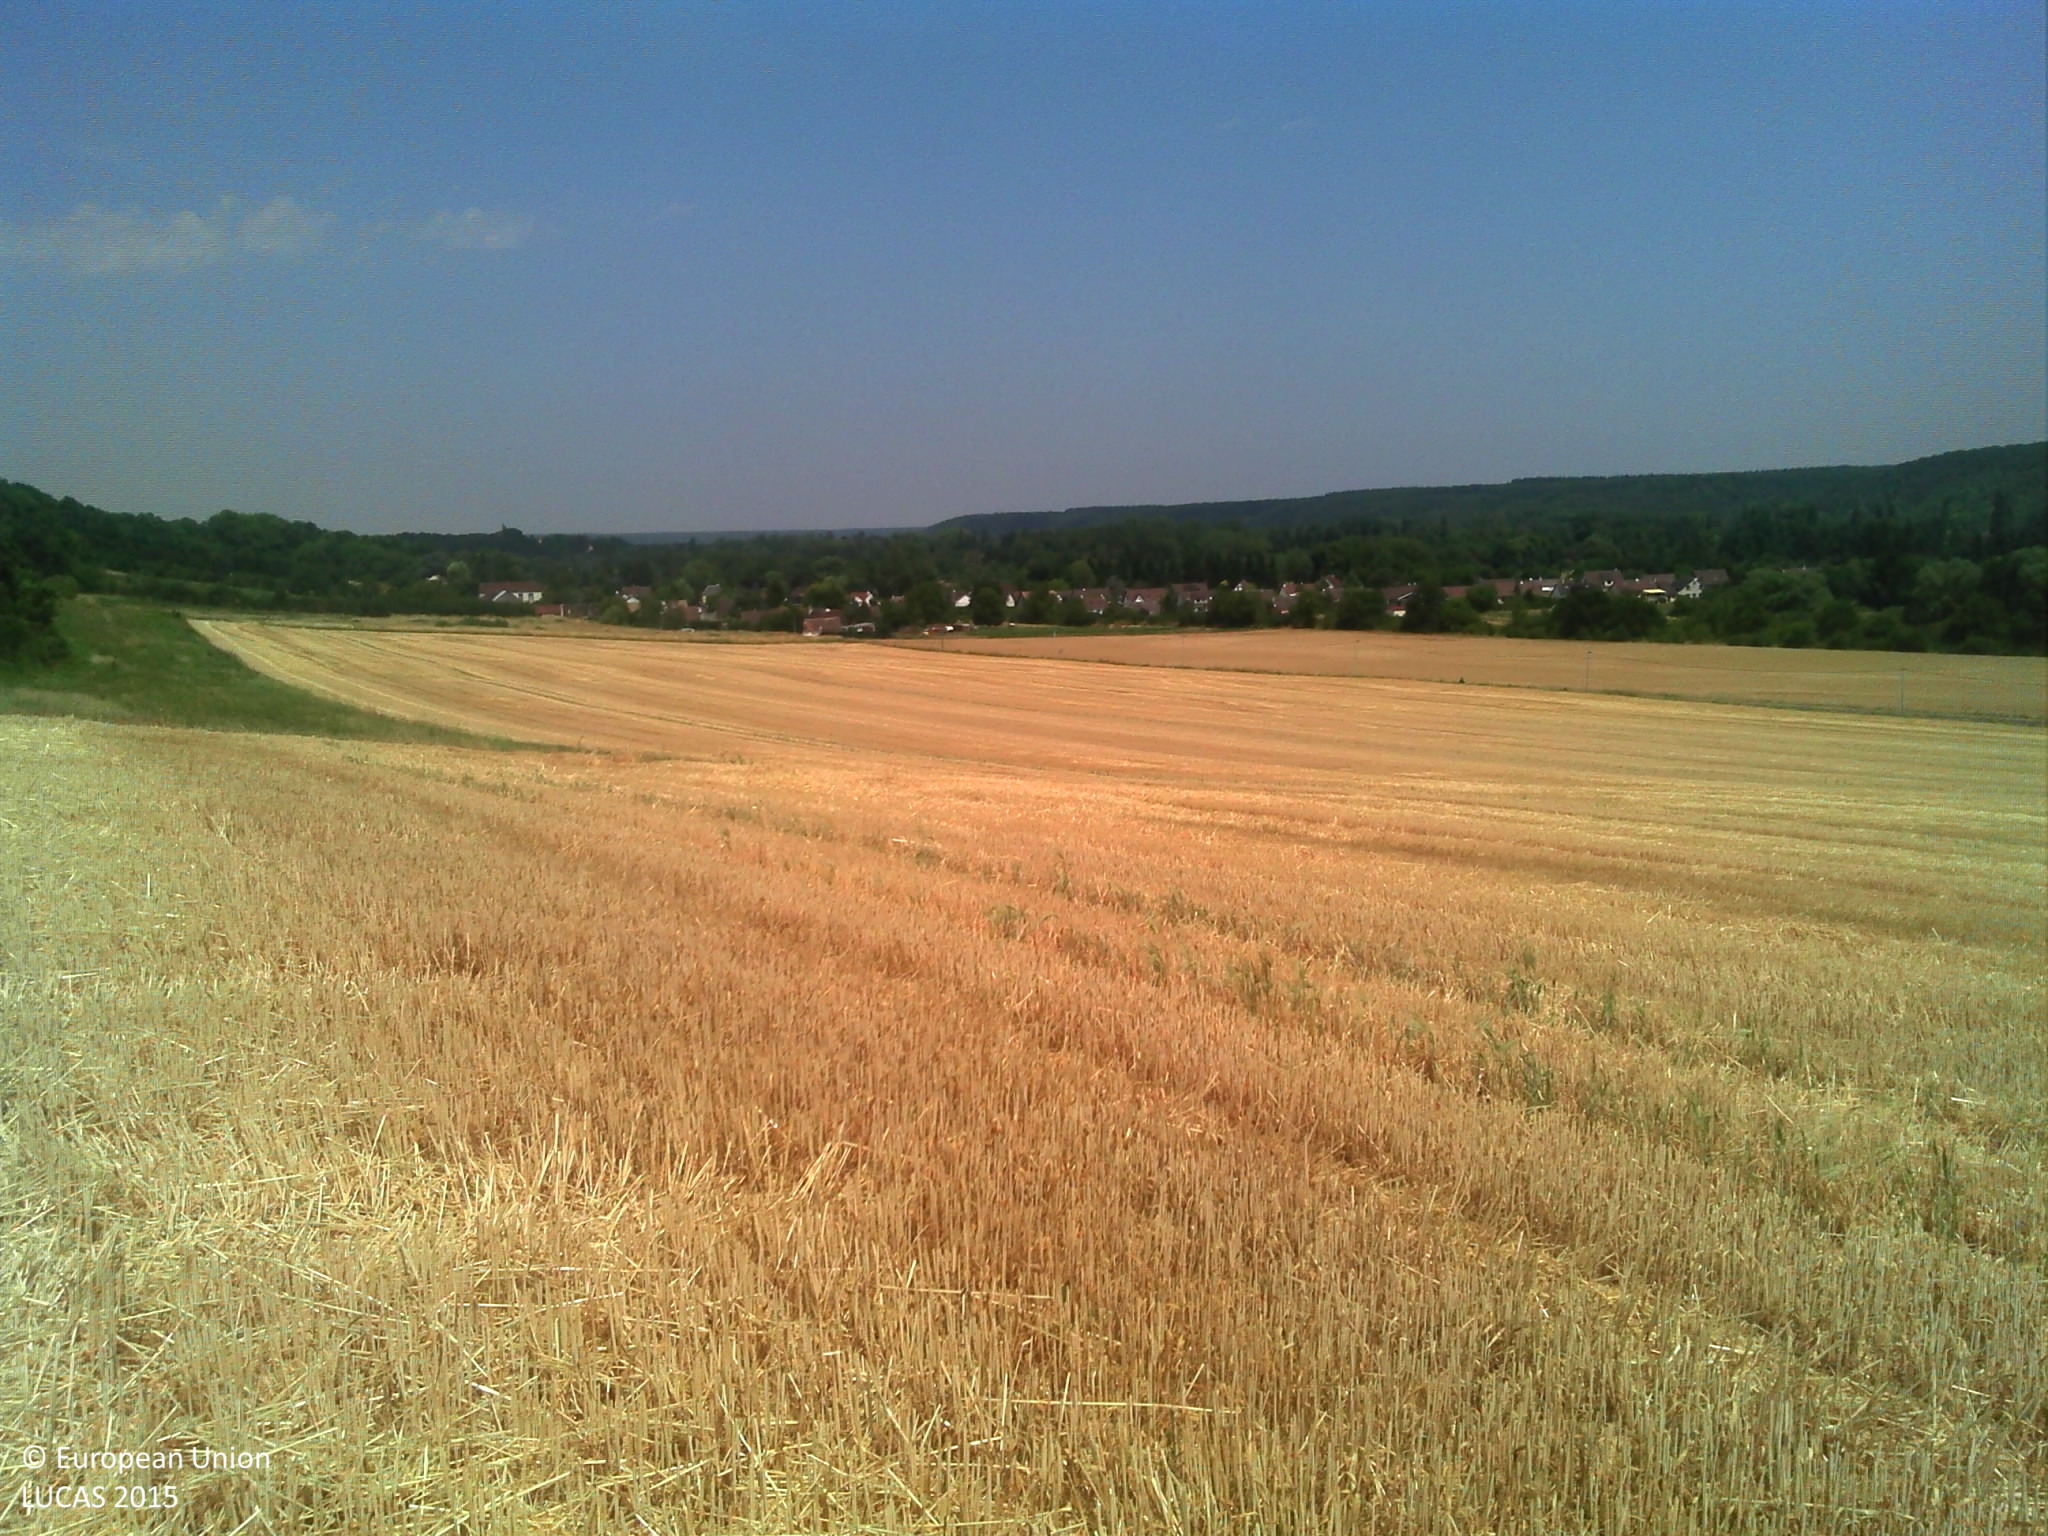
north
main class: Cropland
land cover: Barley
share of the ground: > 75 %
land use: Agriculture (excluding fallow land and kitchen gardens)
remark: Harvested field
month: July
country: FR
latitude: 48.7711
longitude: 1.3687
